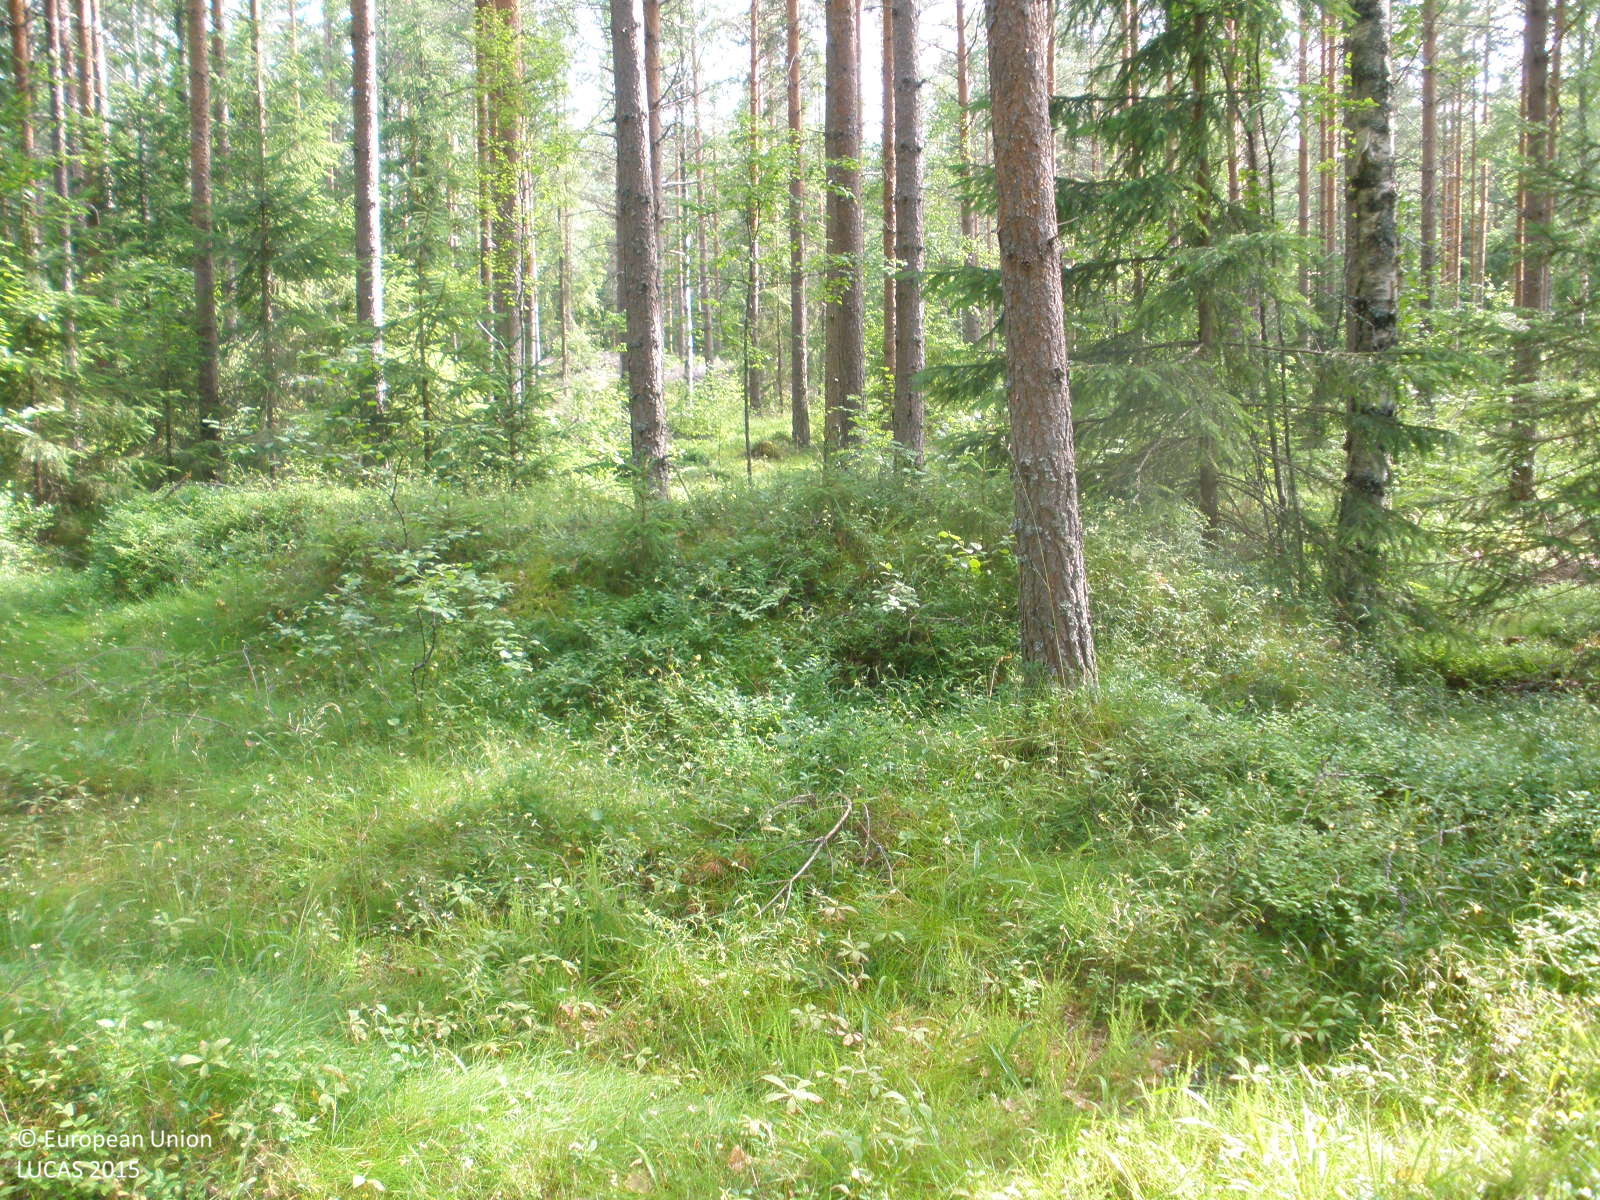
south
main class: Woodland
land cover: Pine dominated coniferous woodland
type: boreal forest
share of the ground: > 75 %
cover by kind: coniferous forest trees 70 %, herbaceous plants 10 %, lichens and mosses 10 %, broadleaved forest trees 5 %, shrubs 5 %
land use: Forestry
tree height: > 5 m
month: July
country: FI
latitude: 61.4574
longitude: 24.5650
